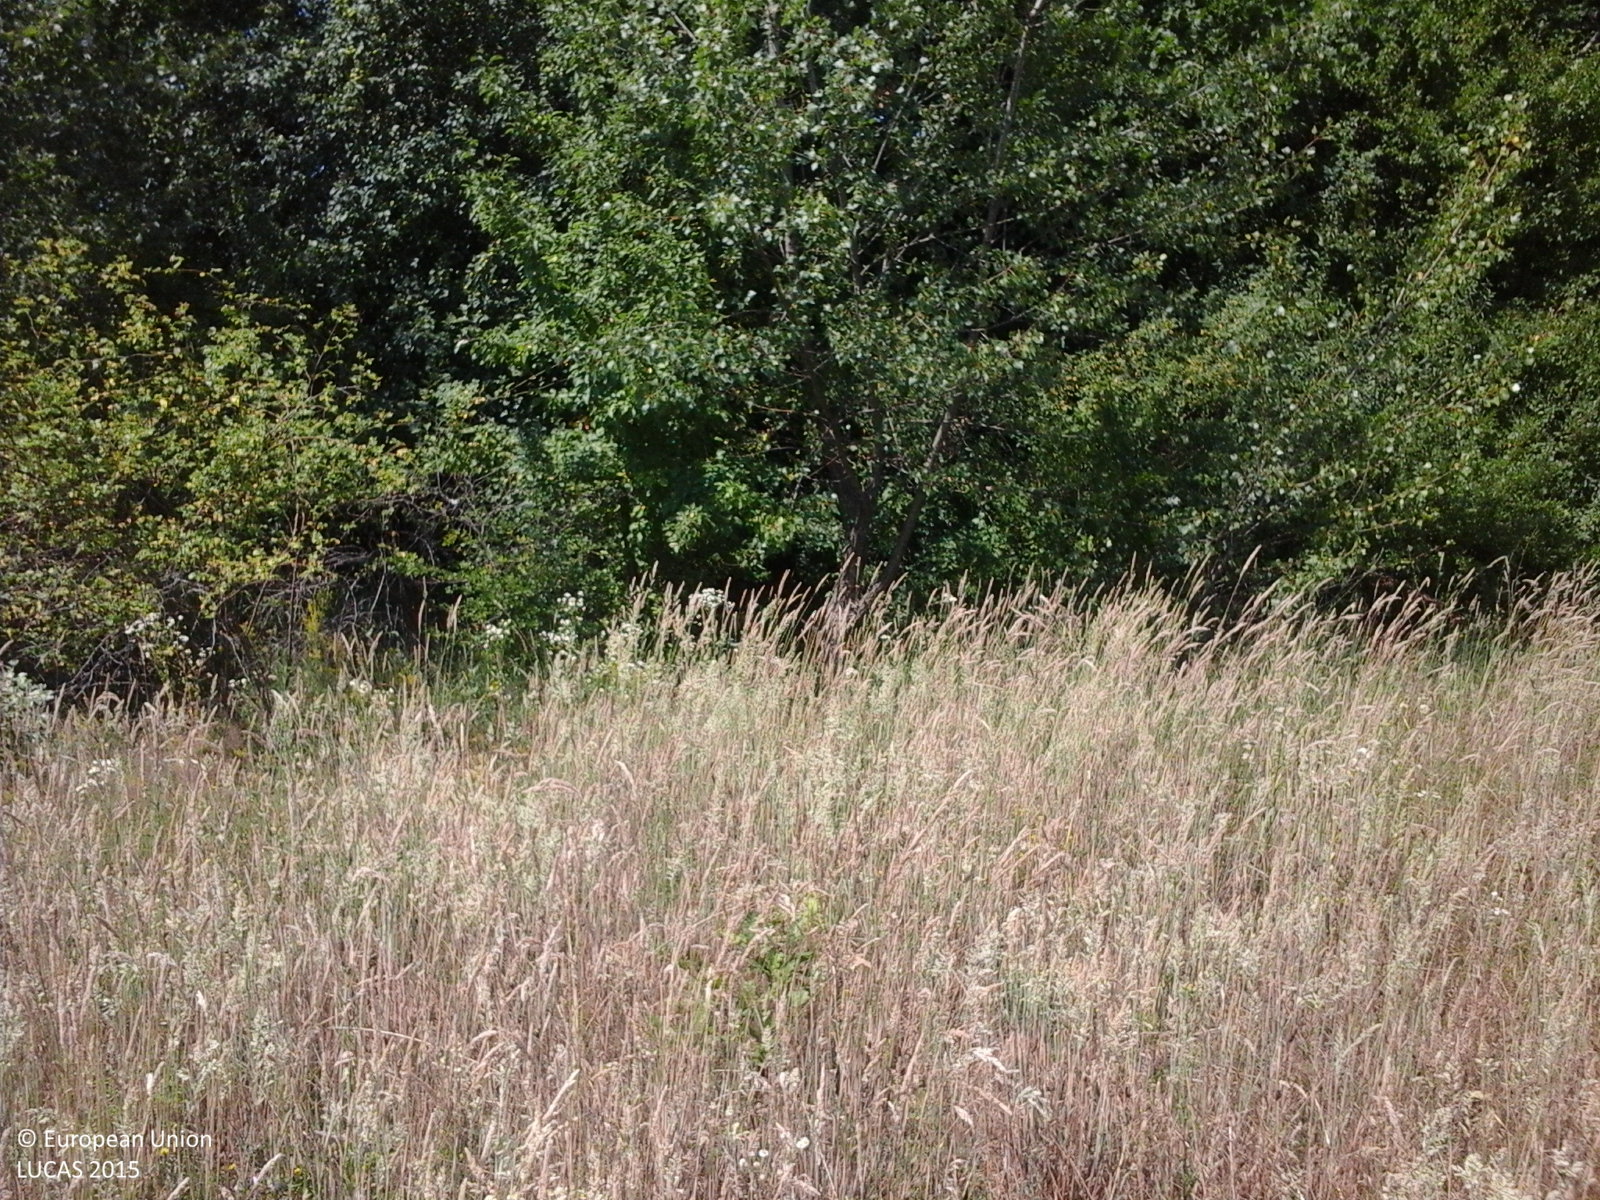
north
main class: Grassland
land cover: Grassland without tree/shrub cover
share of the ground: > 75 %
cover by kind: herbaceous plants 100 %
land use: Agriculture (excluding fallow land and kitchen gardens)
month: July
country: RO
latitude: 44.8821
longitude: 24.6231
